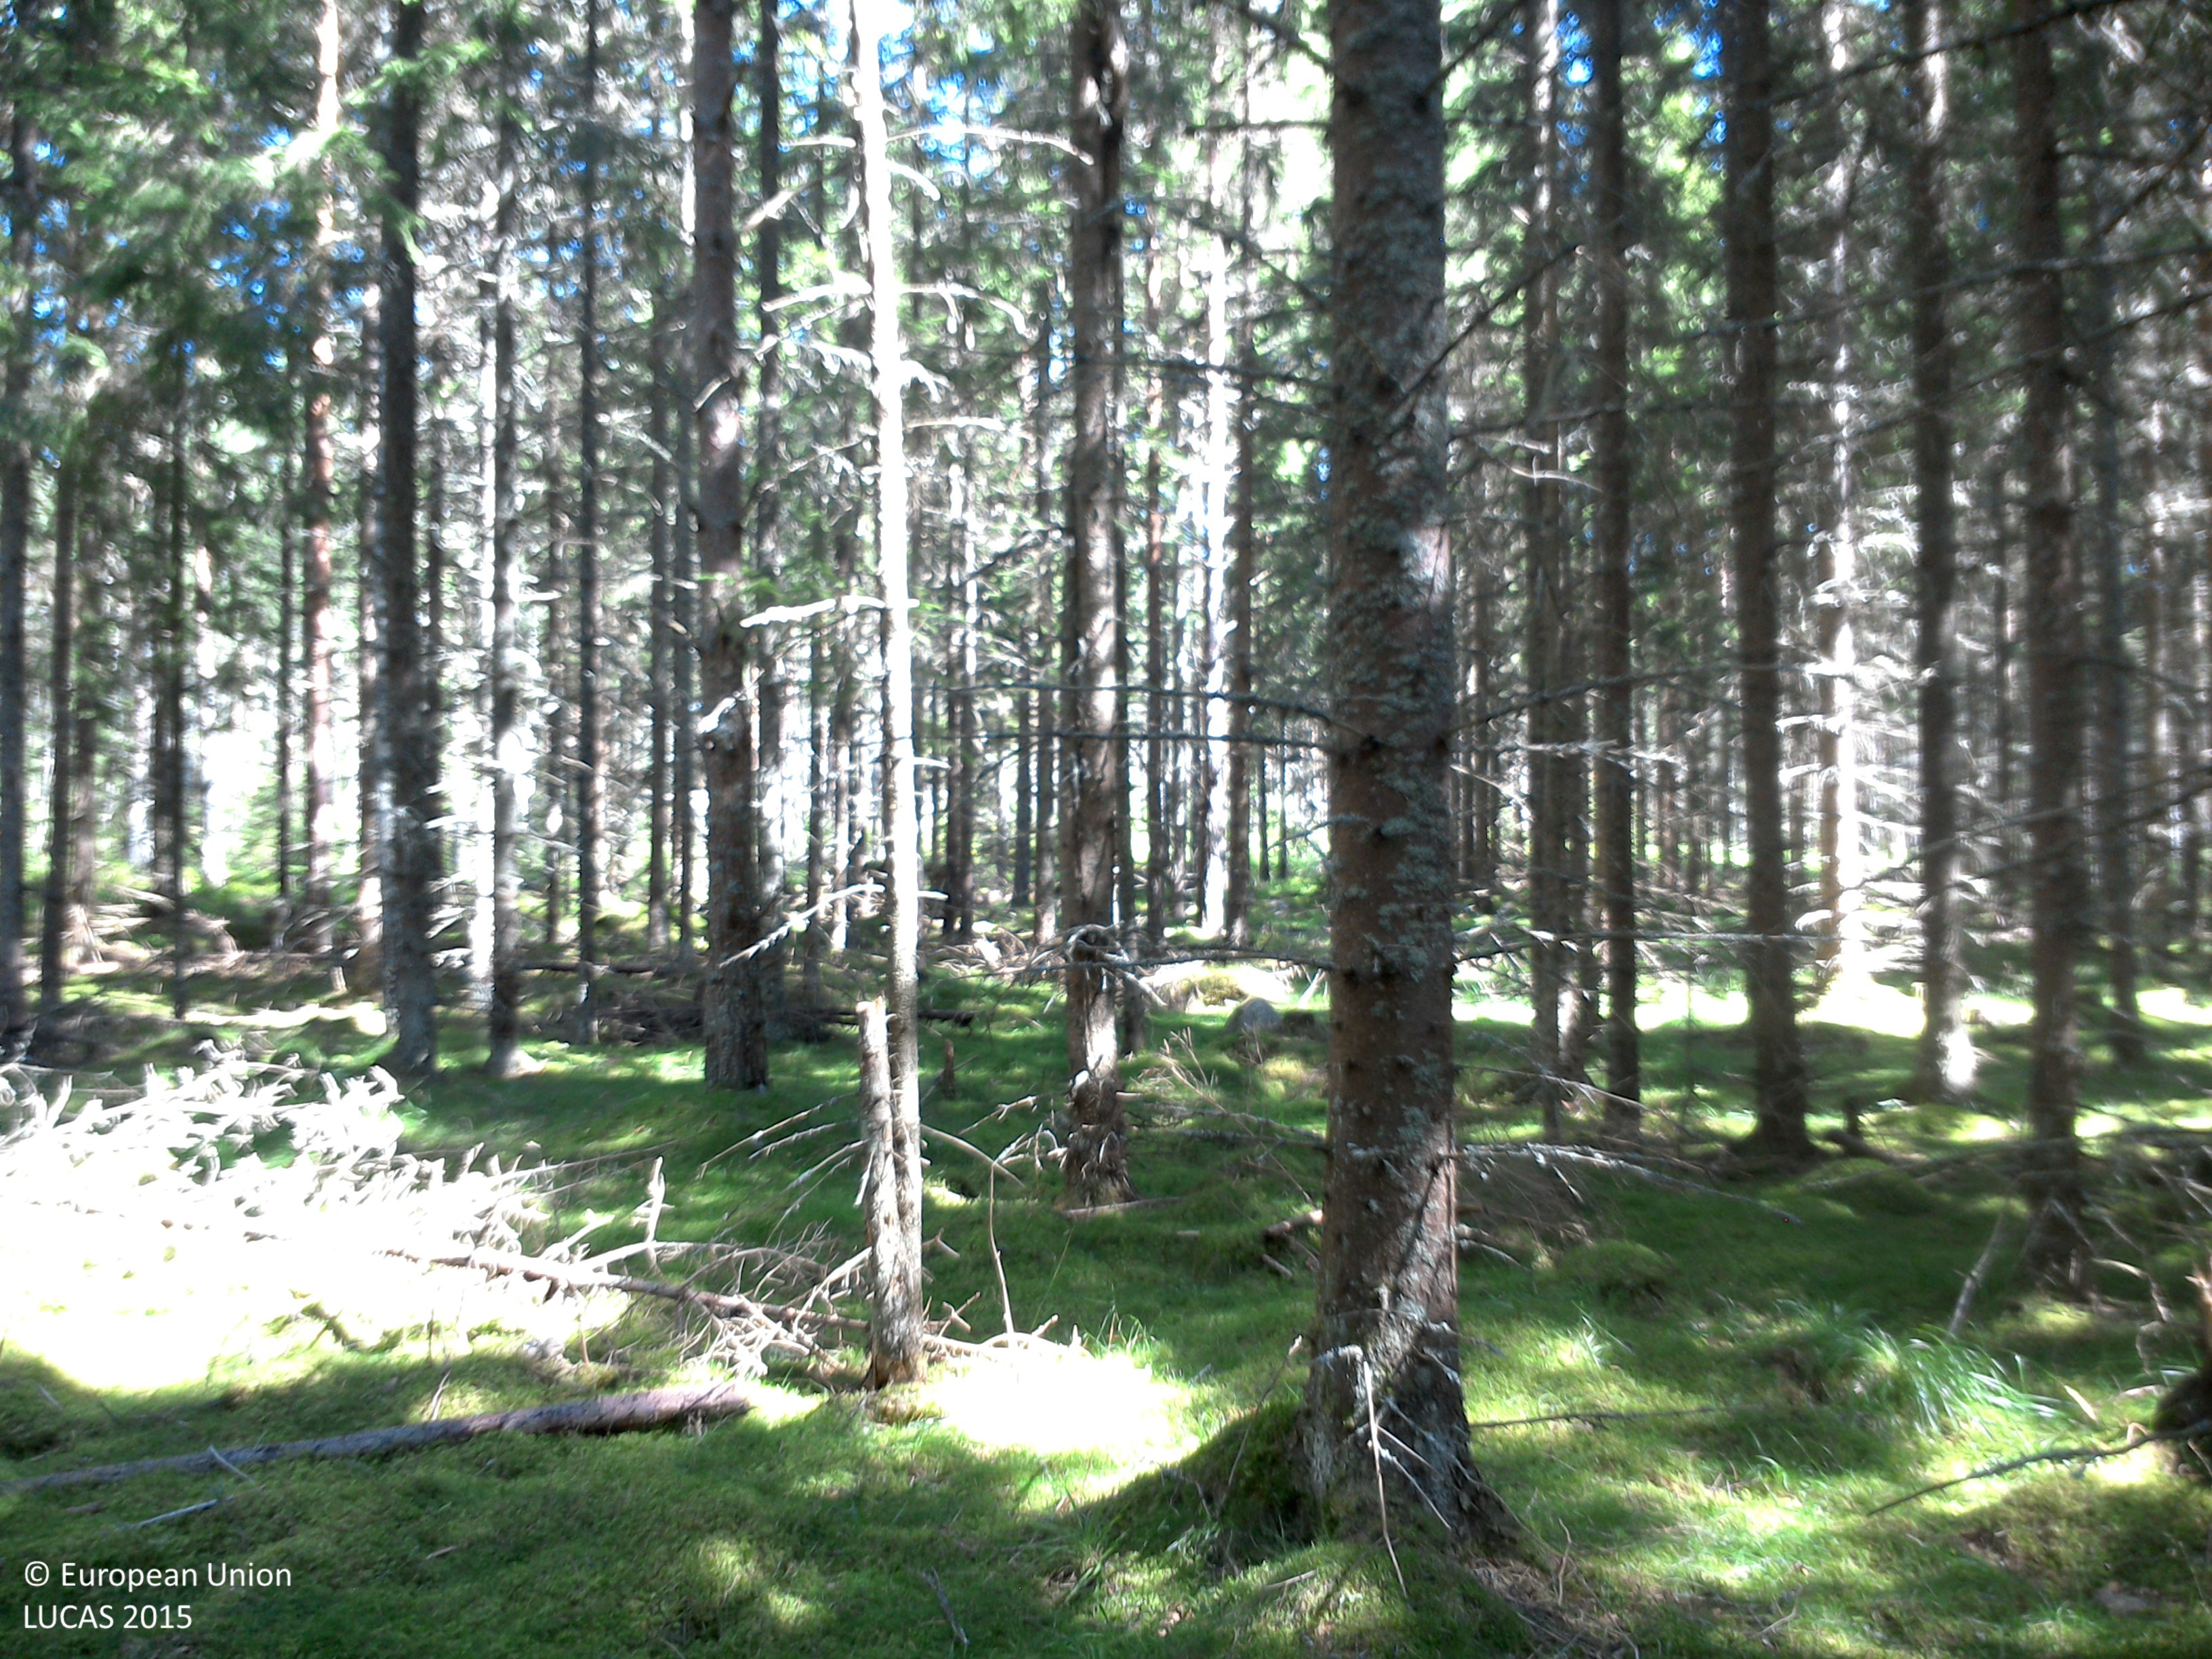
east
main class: Woodland
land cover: Spruce dominated coniferous woodland
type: boreal forest
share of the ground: 50 - 75 %
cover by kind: coniferous forest trees 70 %, lichens and mosses 30 %
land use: Forestry
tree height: > 5 m
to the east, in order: Spruce dominated coniferous woodland; Paved roads, cycling and walking lanes; Pine dominated coniferous woodland; Pine dominated mixed woodland; Pine dominated coniferous woodland
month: August
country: SE
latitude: 57.9467
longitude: 15.4524
